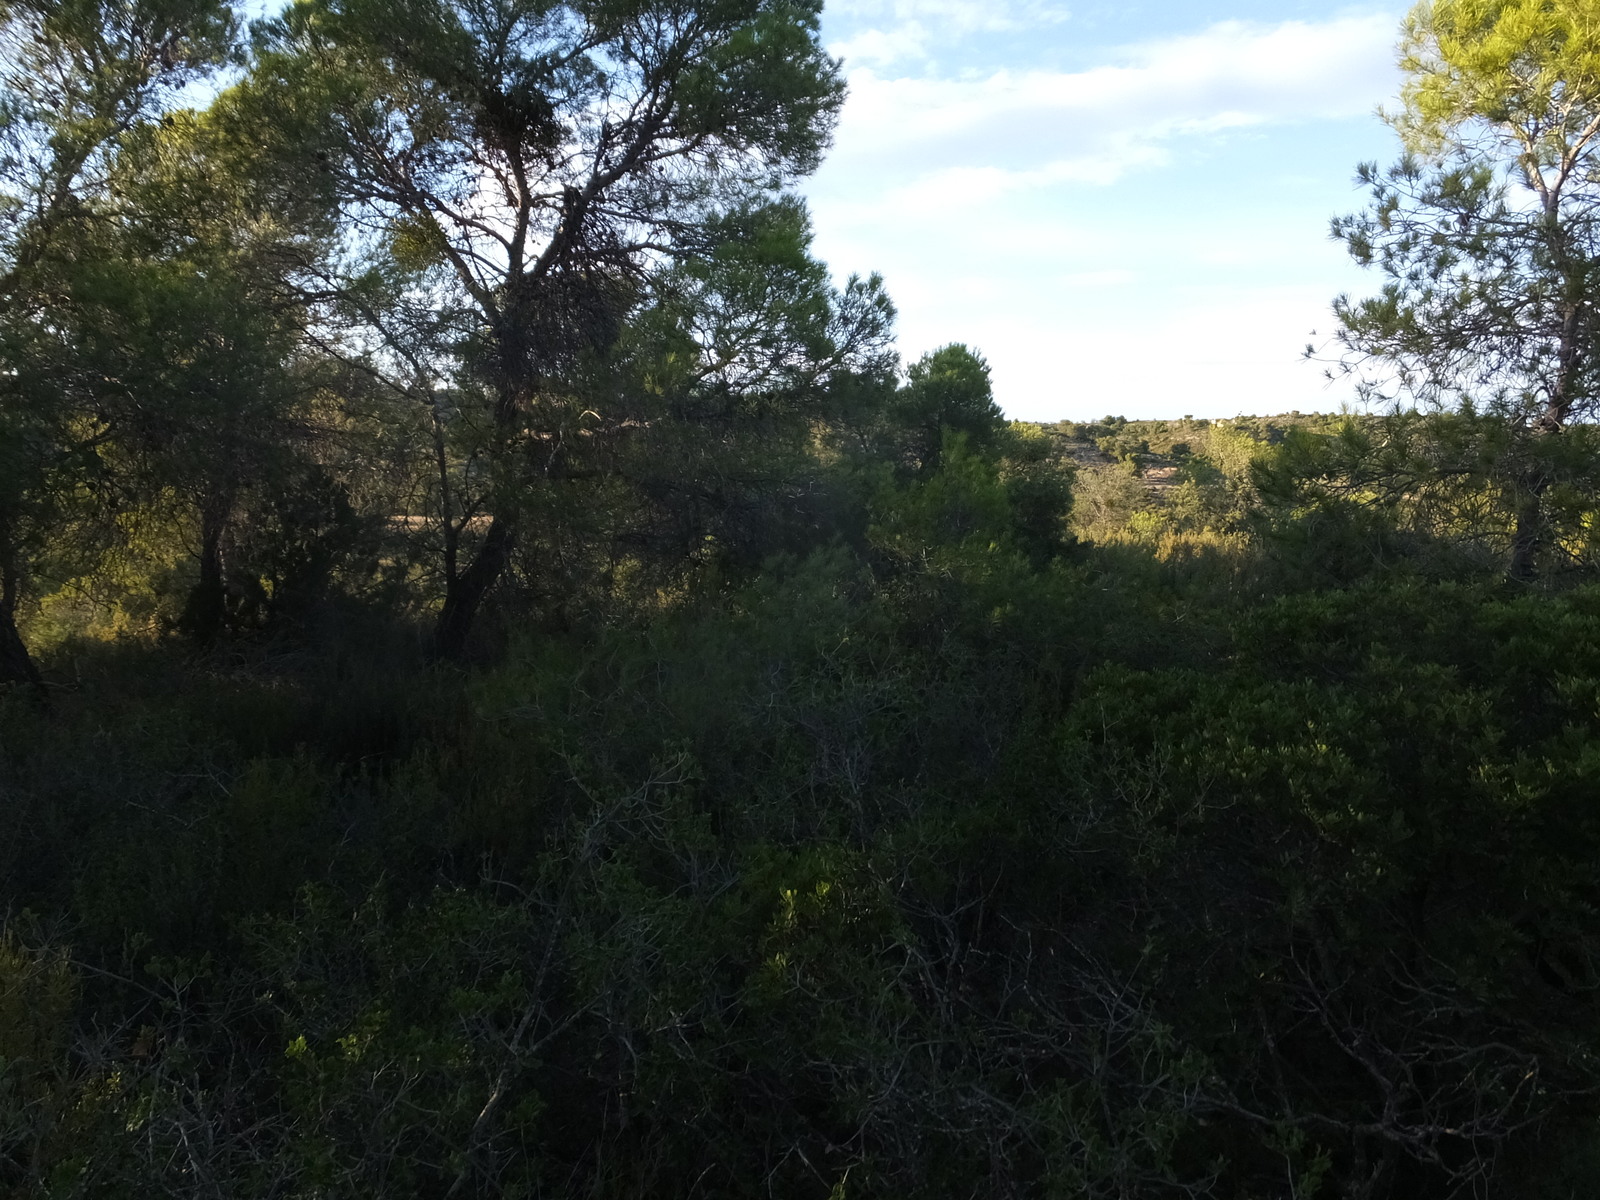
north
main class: Woodland
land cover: Pine dominated mixed woodland
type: coniferous forest of the mediterranean region
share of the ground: 50 - 75 %
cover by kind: coniferous forest trees 60 %, broadleaved forest trees 20 %, shrubs 20 %
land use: Forestry
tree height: > 5 m
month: August
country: ES
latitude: 41.2064
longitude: 0.1260
